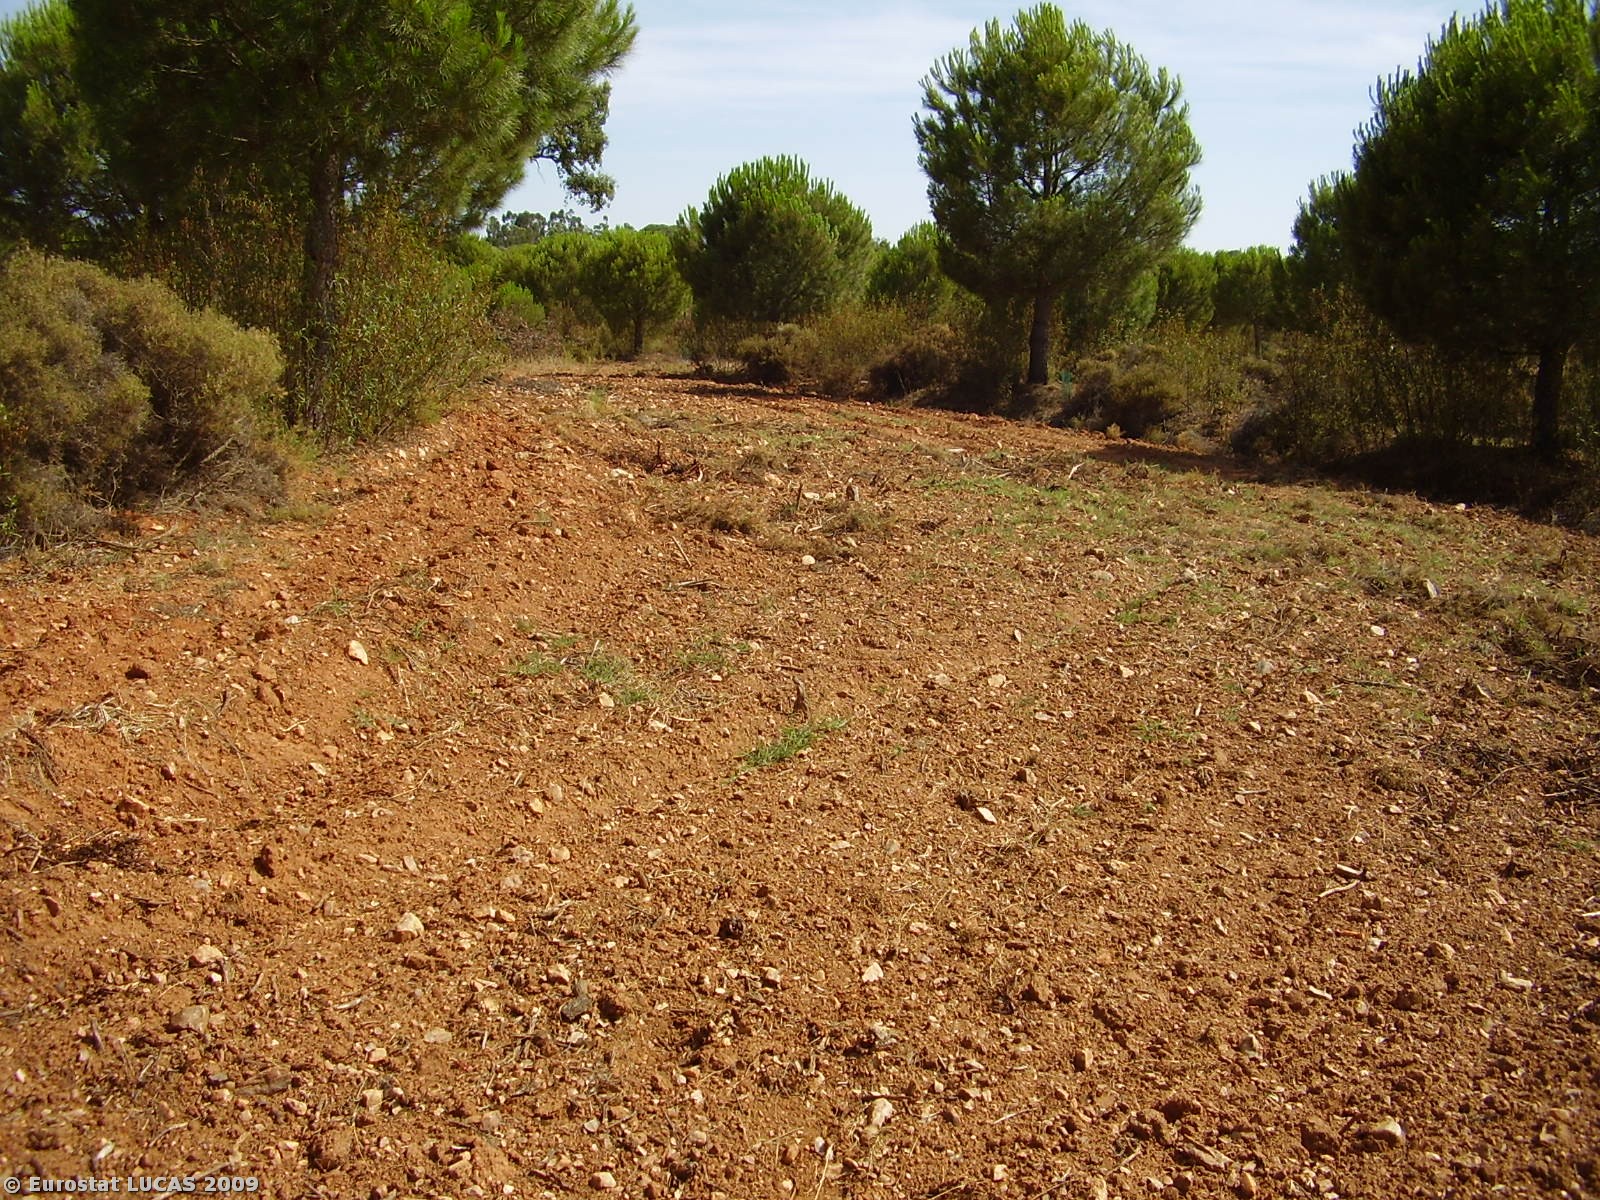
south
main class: Woodland
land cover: Coniferous woodland
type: coniferous forest of the mediterranean region
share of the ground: 10 - 25 %
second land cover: Bare land
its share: 50 - 75 %
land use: Forestry
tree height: > 5 m
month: July
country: PT
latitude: 38.5615
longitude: -7.7431
